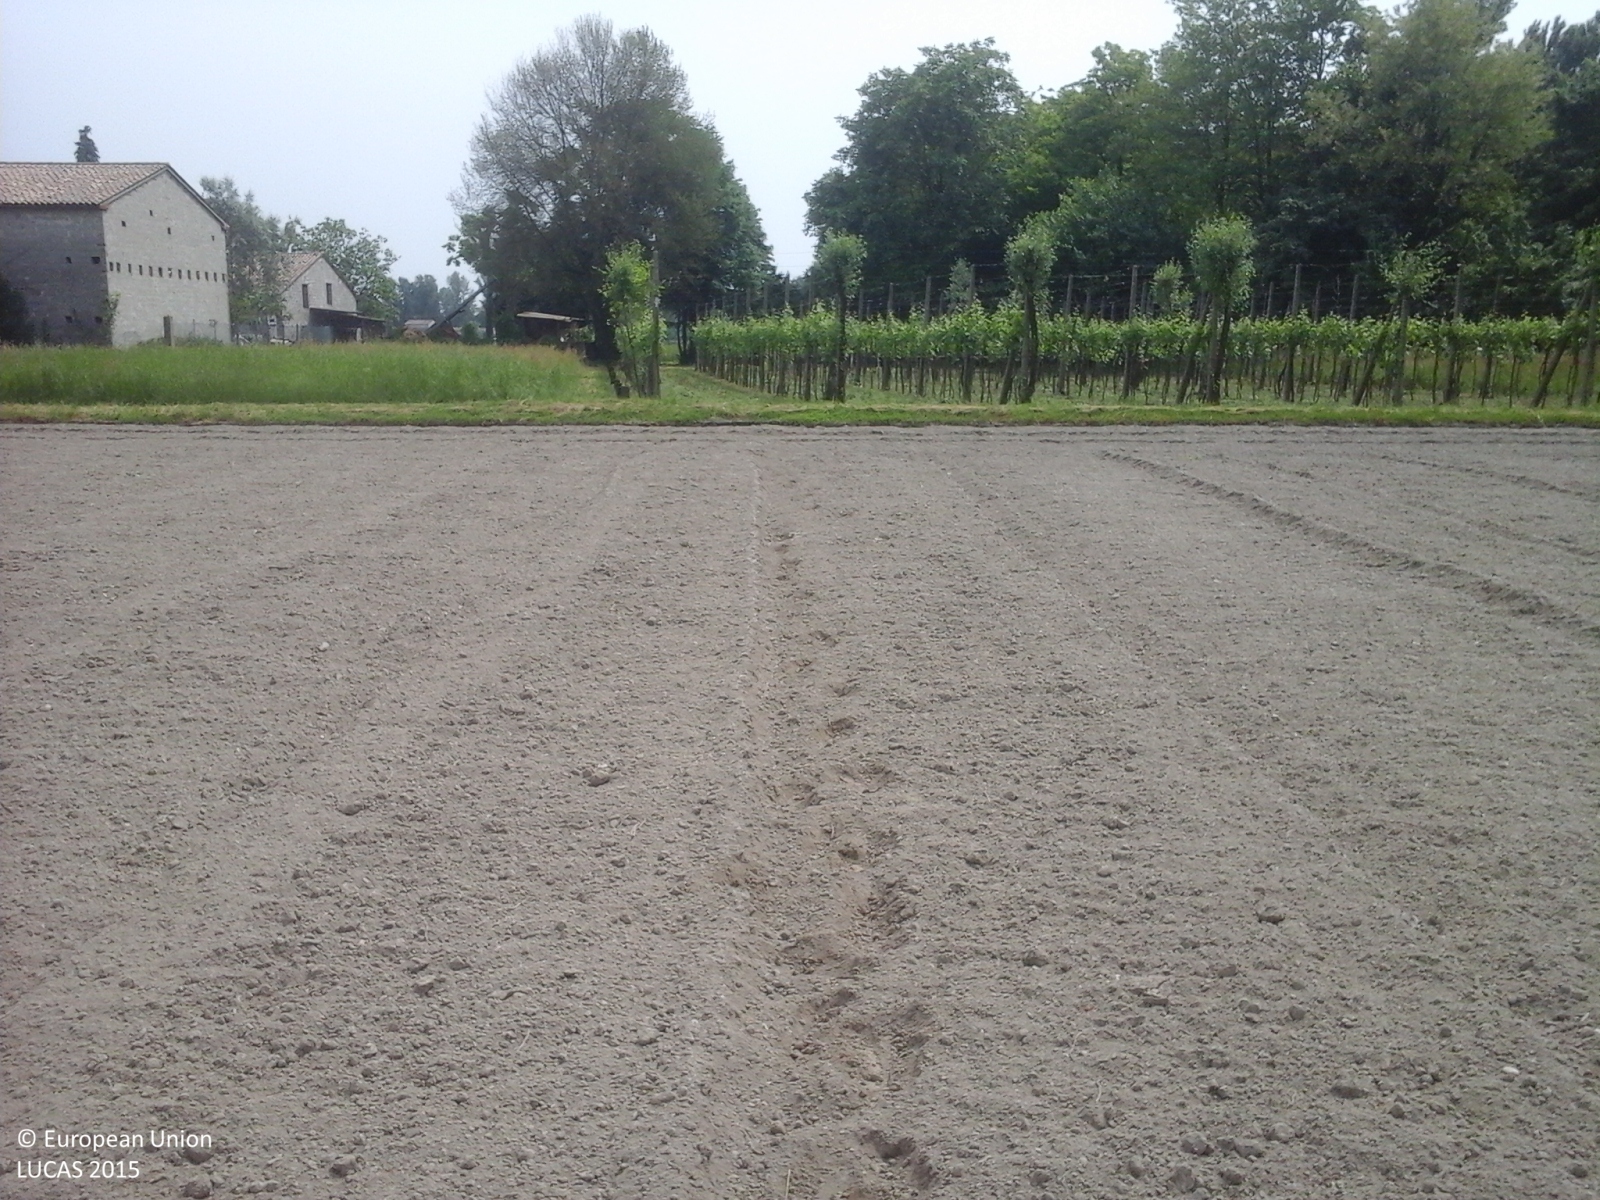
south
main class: Cropland
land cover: Other fresh vegetables
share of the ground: < 10 %
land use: Agriculture (excluding fallow land and kitchen gardens)
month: May
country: IT
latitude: 45.6160
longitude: 11.7541
